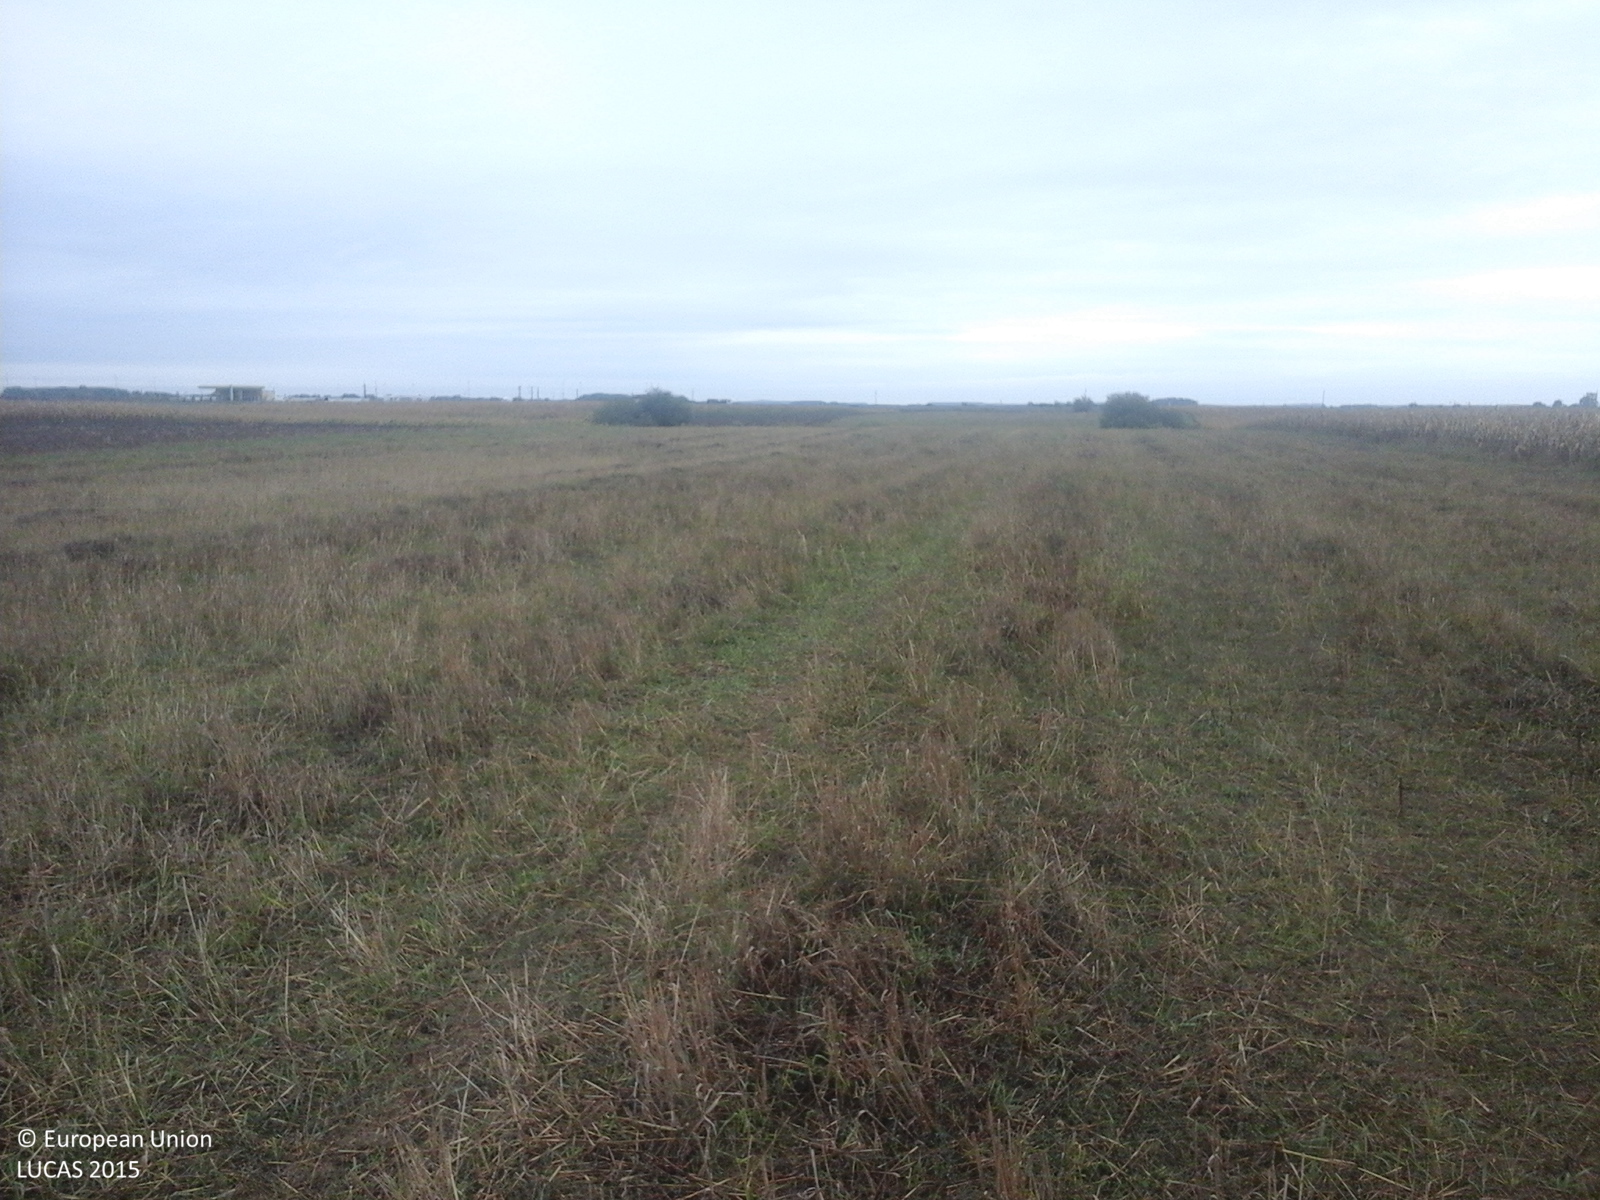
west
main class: Cropland
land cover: Common wheat
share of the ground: 10 - 25 %
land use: Agriculture (excluding fallow land and kitchen gardens)
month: September
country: RO
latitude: 47.2433
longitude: 21.9508
